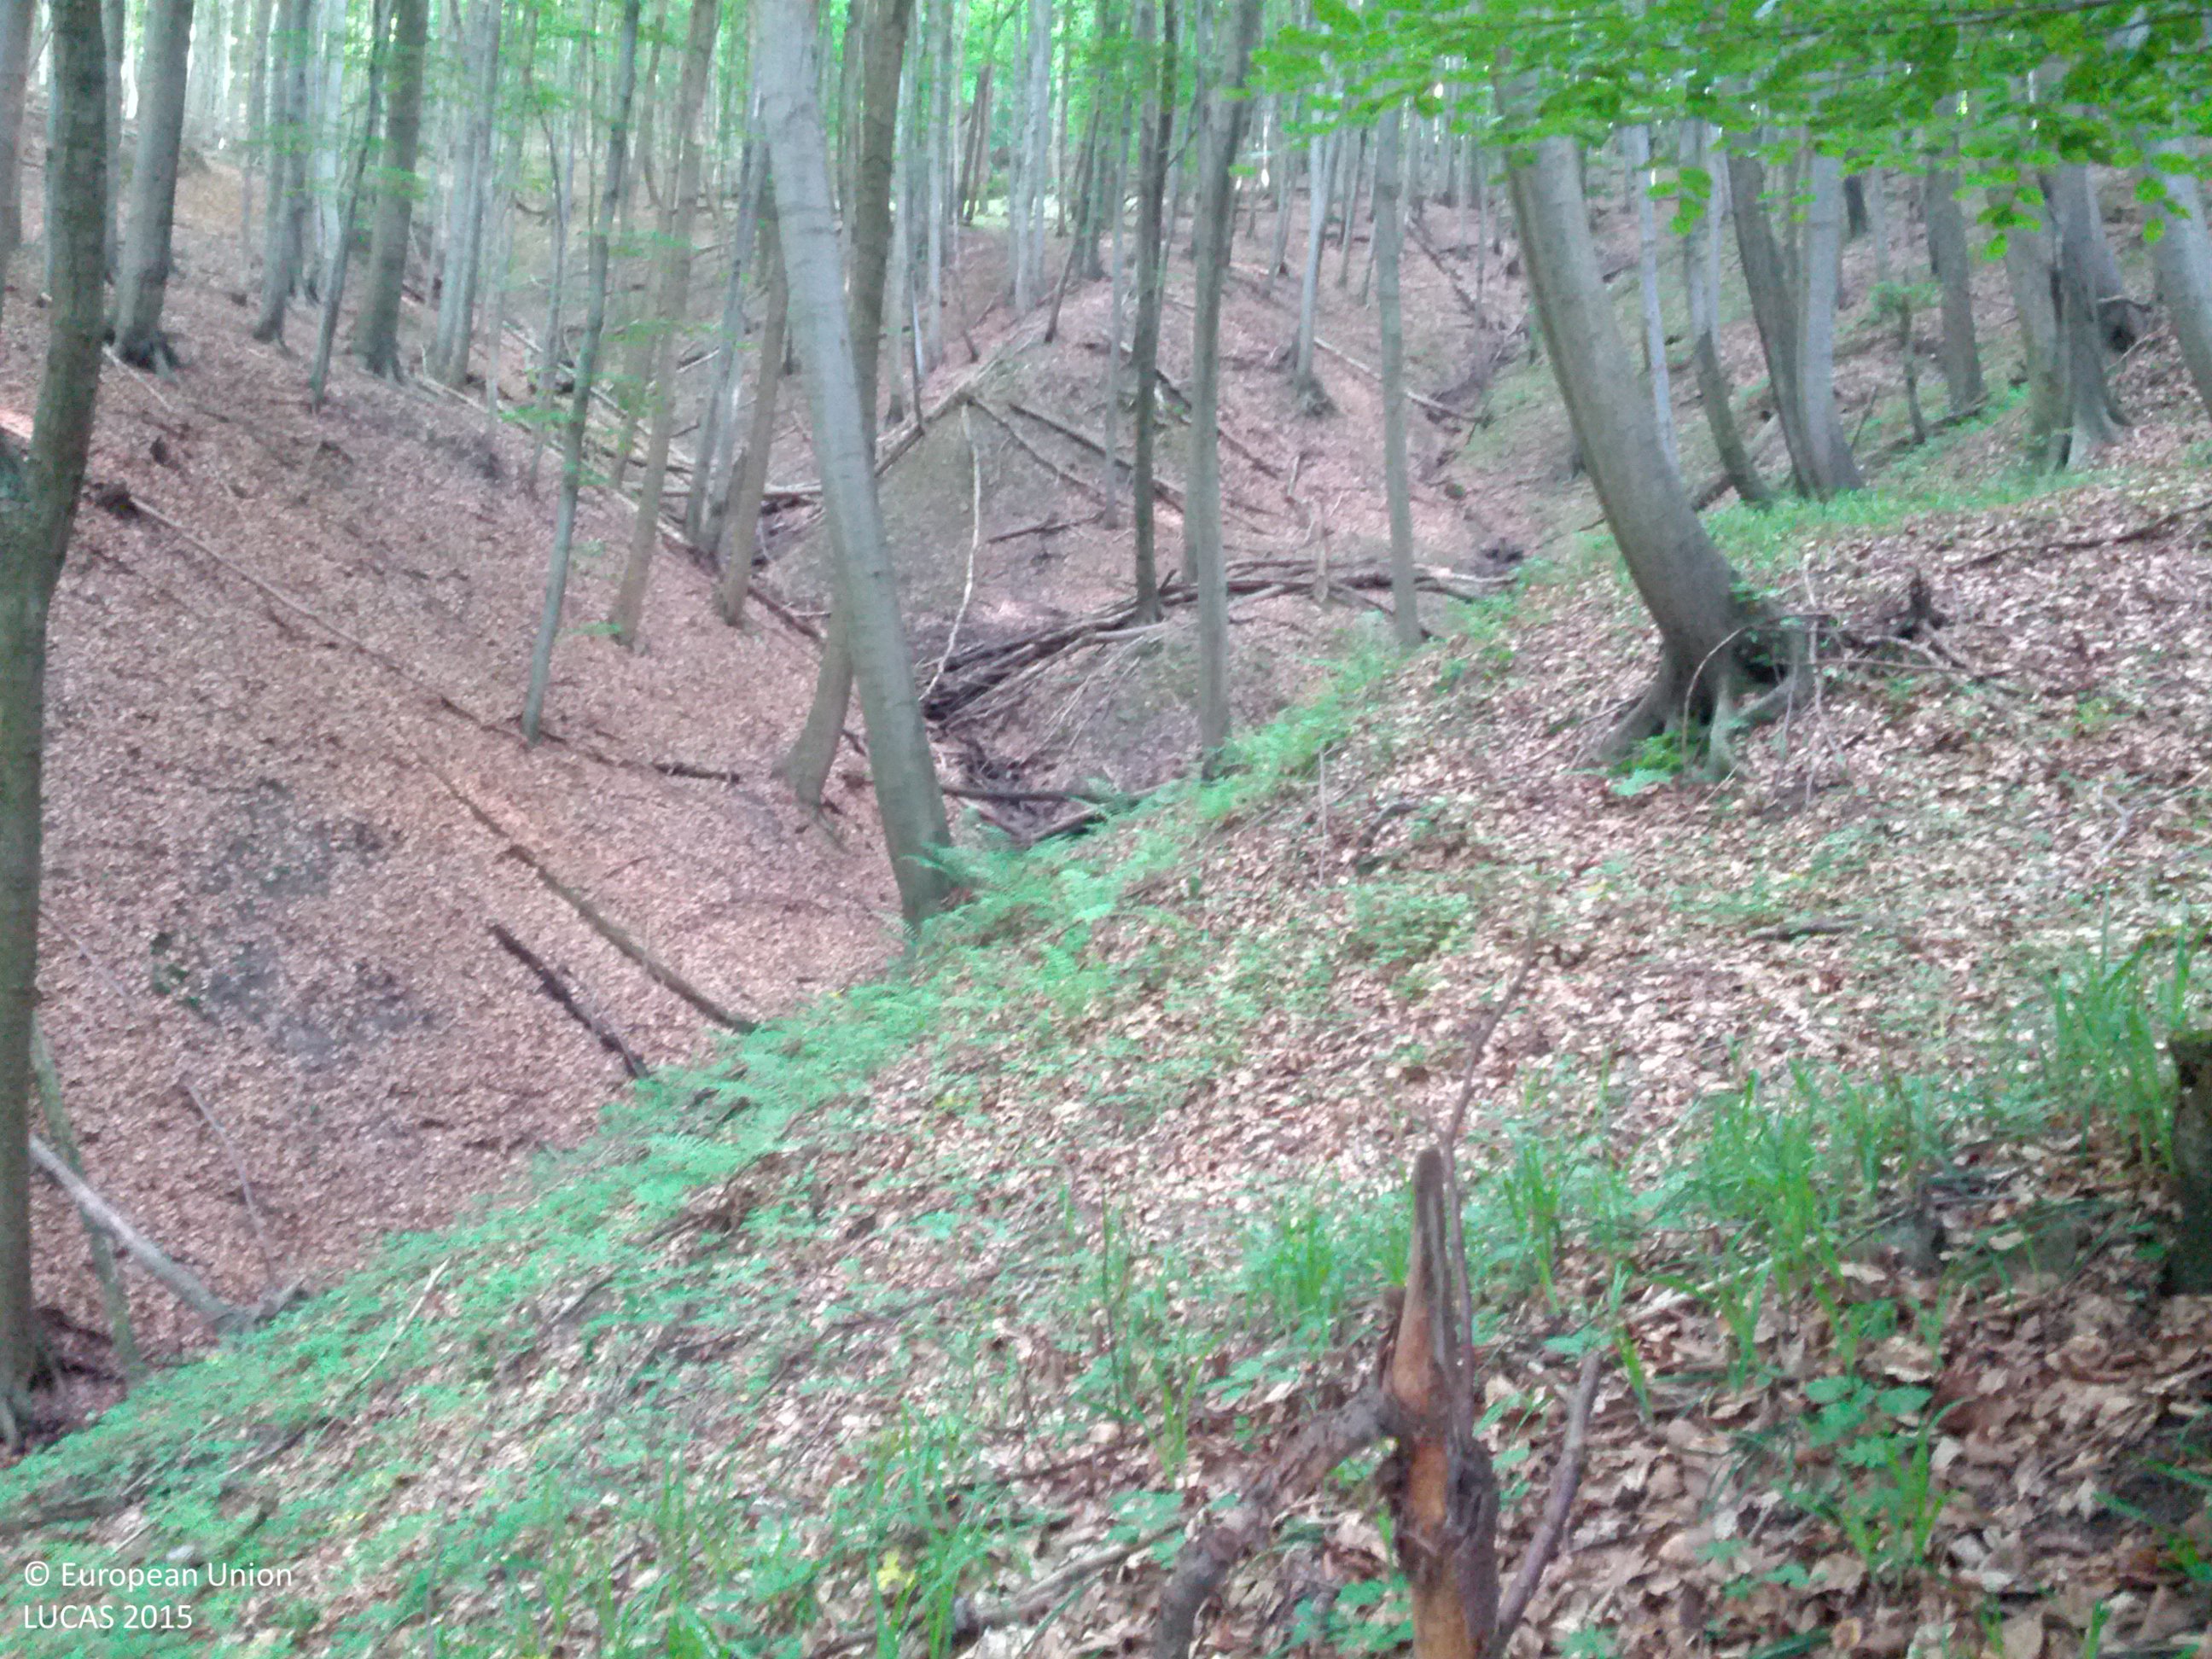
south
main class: Woodland
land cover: Broadleaved woodland
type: beech forest
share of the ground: > 75 %
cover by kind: broadleaved forest trees 95 %, herbaceous plants 5 %
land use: Forestry
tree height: > 5 m
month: May
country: AT
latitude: 48.2632
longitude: 16.2418
